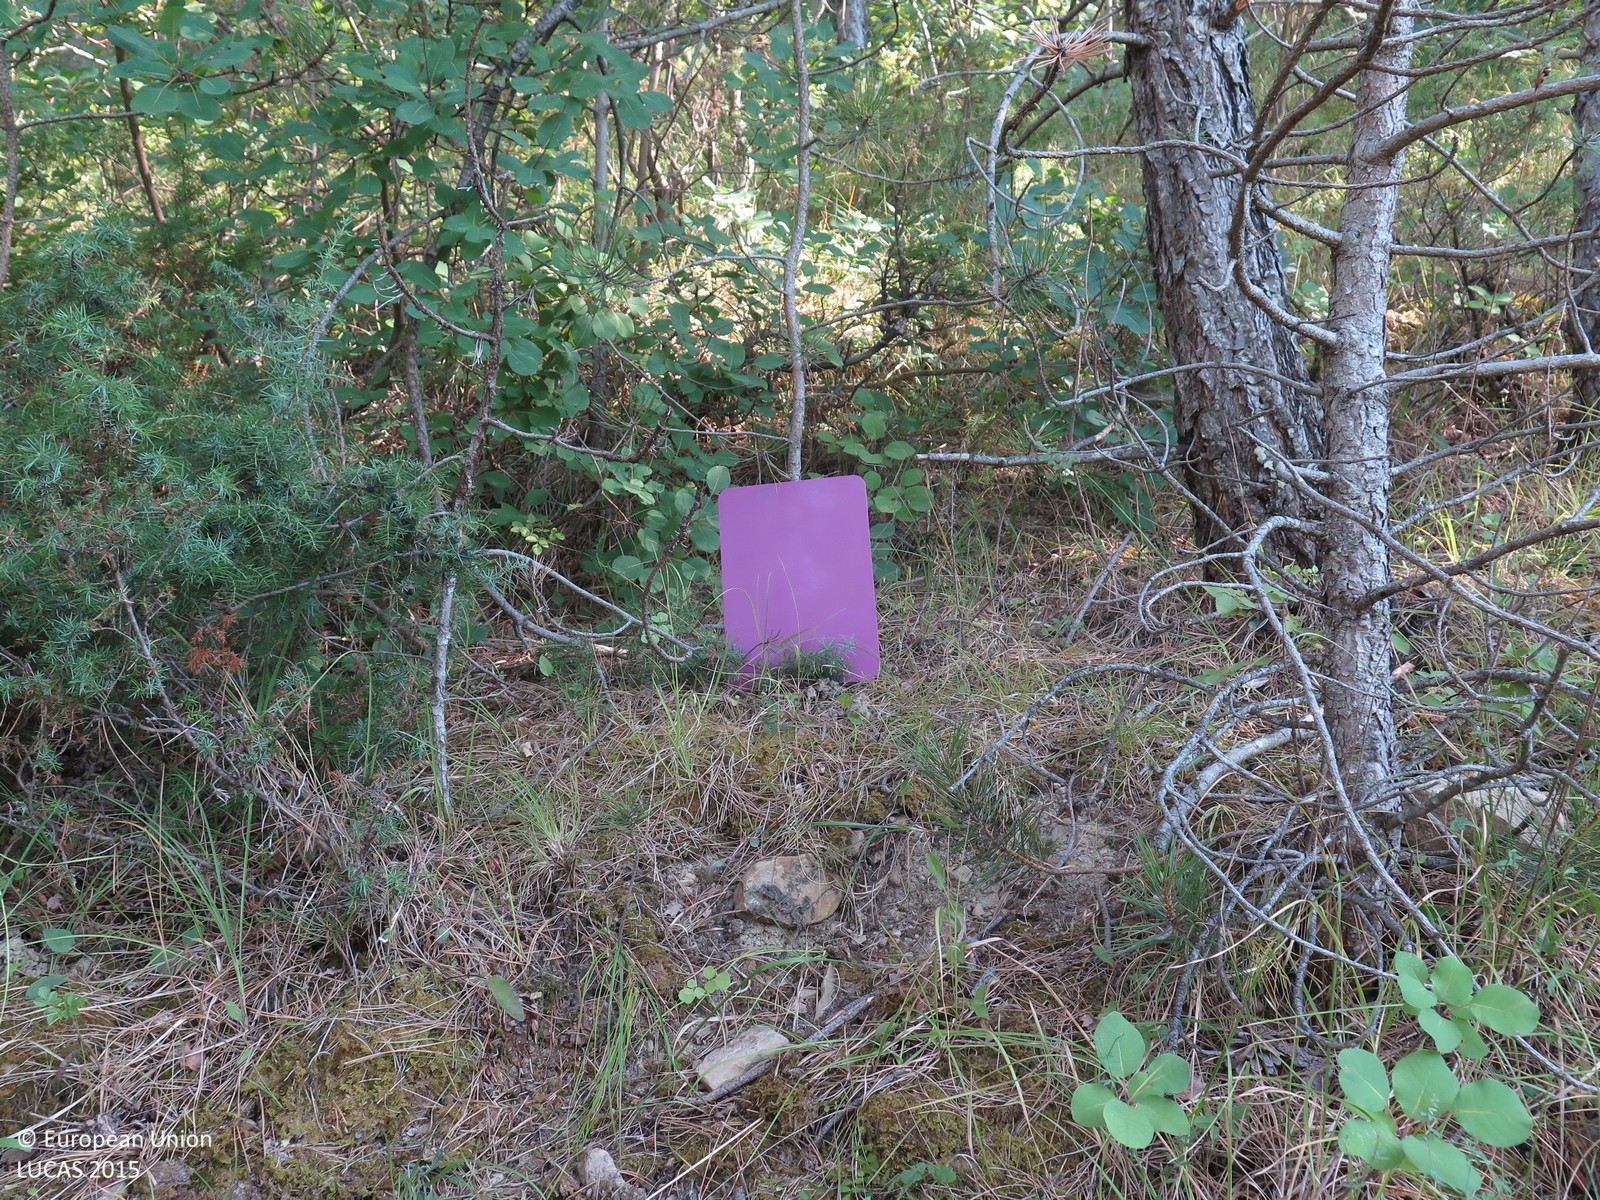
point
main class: Woodland
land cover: Pine dominated coniferous woodland
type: coniferous forest of the mediterranean region
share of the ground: > 75 %
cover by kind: coniferous forest trees 90 %, shrubs 5 %, herbaceous plants 5 %
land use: Semi-natural and natural areas not in use
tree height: > 5 m
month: July
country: HR
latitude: 45.3606
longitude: 13.8887
